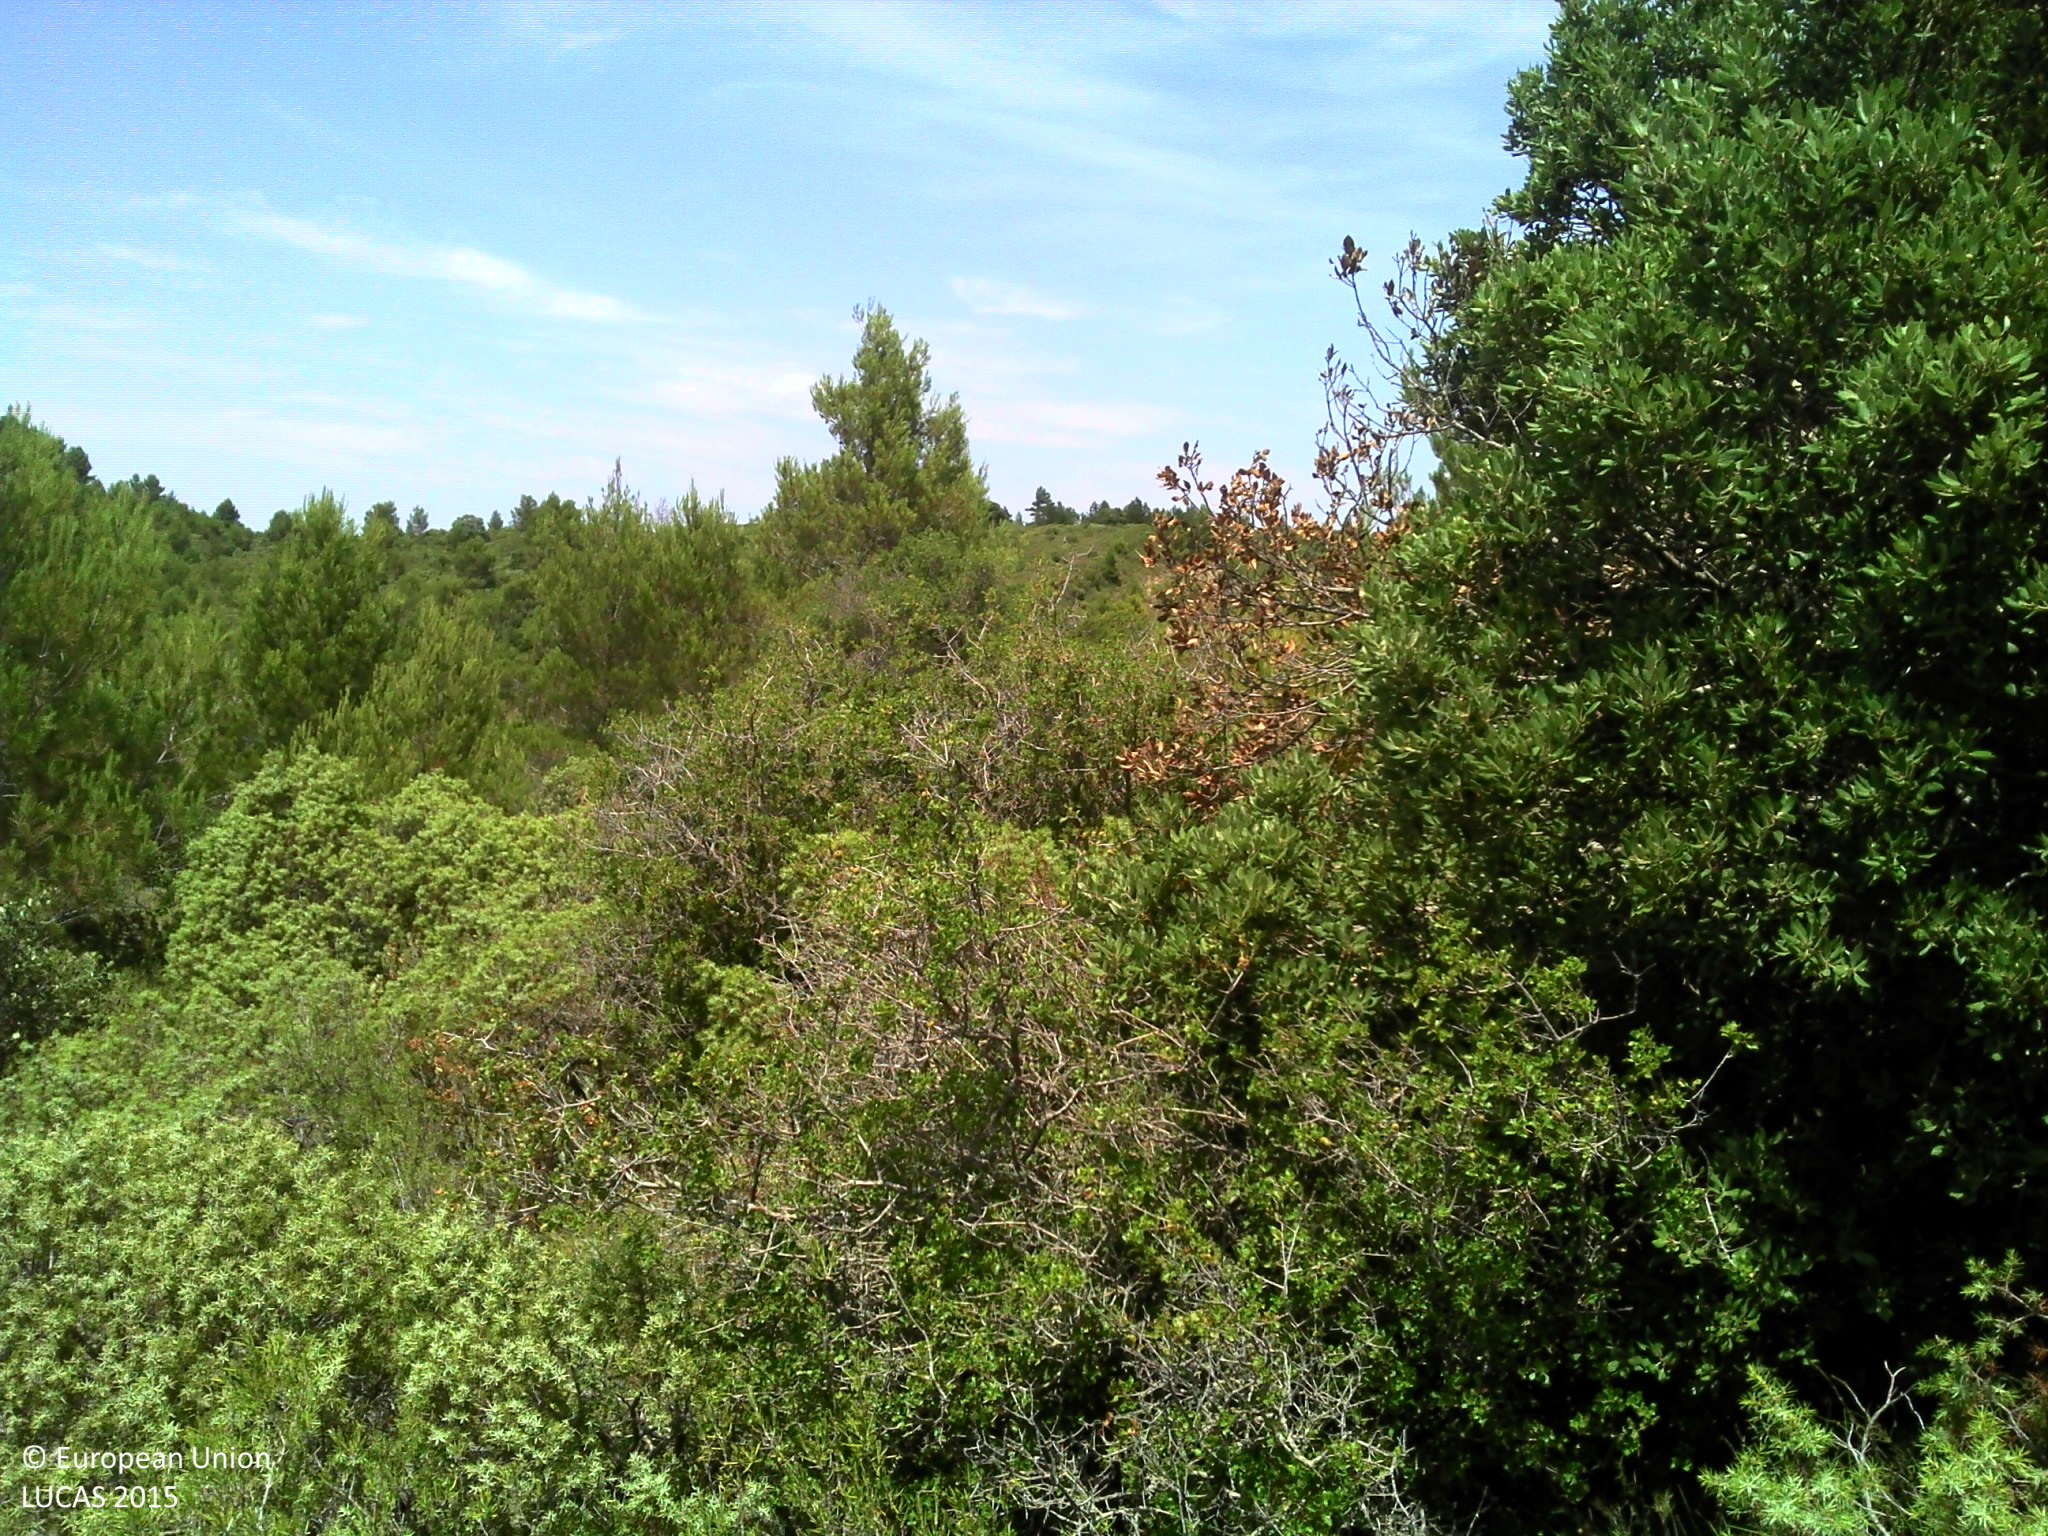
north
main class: Shrubland
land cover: Shrubland with sparse tree cover
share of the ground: > 75 %
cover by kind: shrubs 95 %, broadleaved forest trees 5 %
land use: Semi-natural and natural areas not in use
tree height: < 5 m
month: July
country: FR
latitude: 43.0450
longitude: 2.7304
